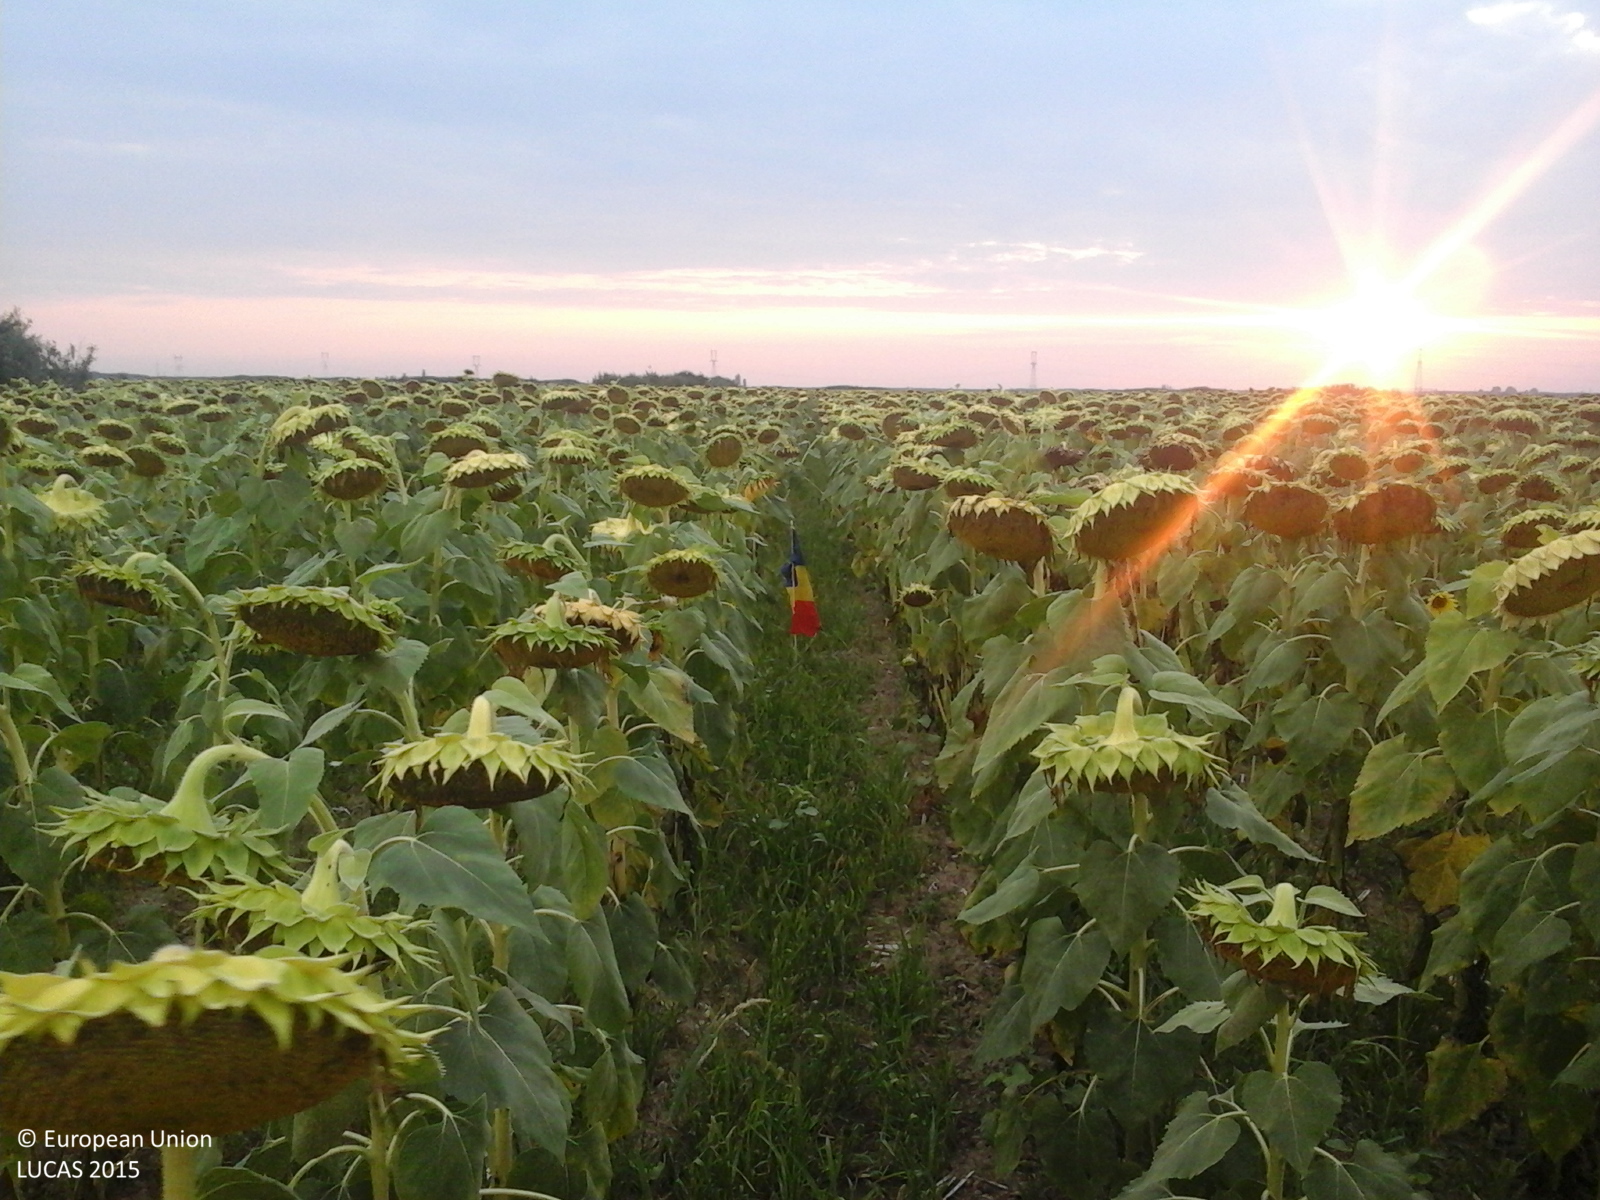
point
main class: Cropland
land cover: Sunflower
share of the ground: > 75 %
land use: Agriculture (excluding fallow land and kitchen gardens)
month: August
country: RO
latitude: 46.5029
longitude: 21.5711
